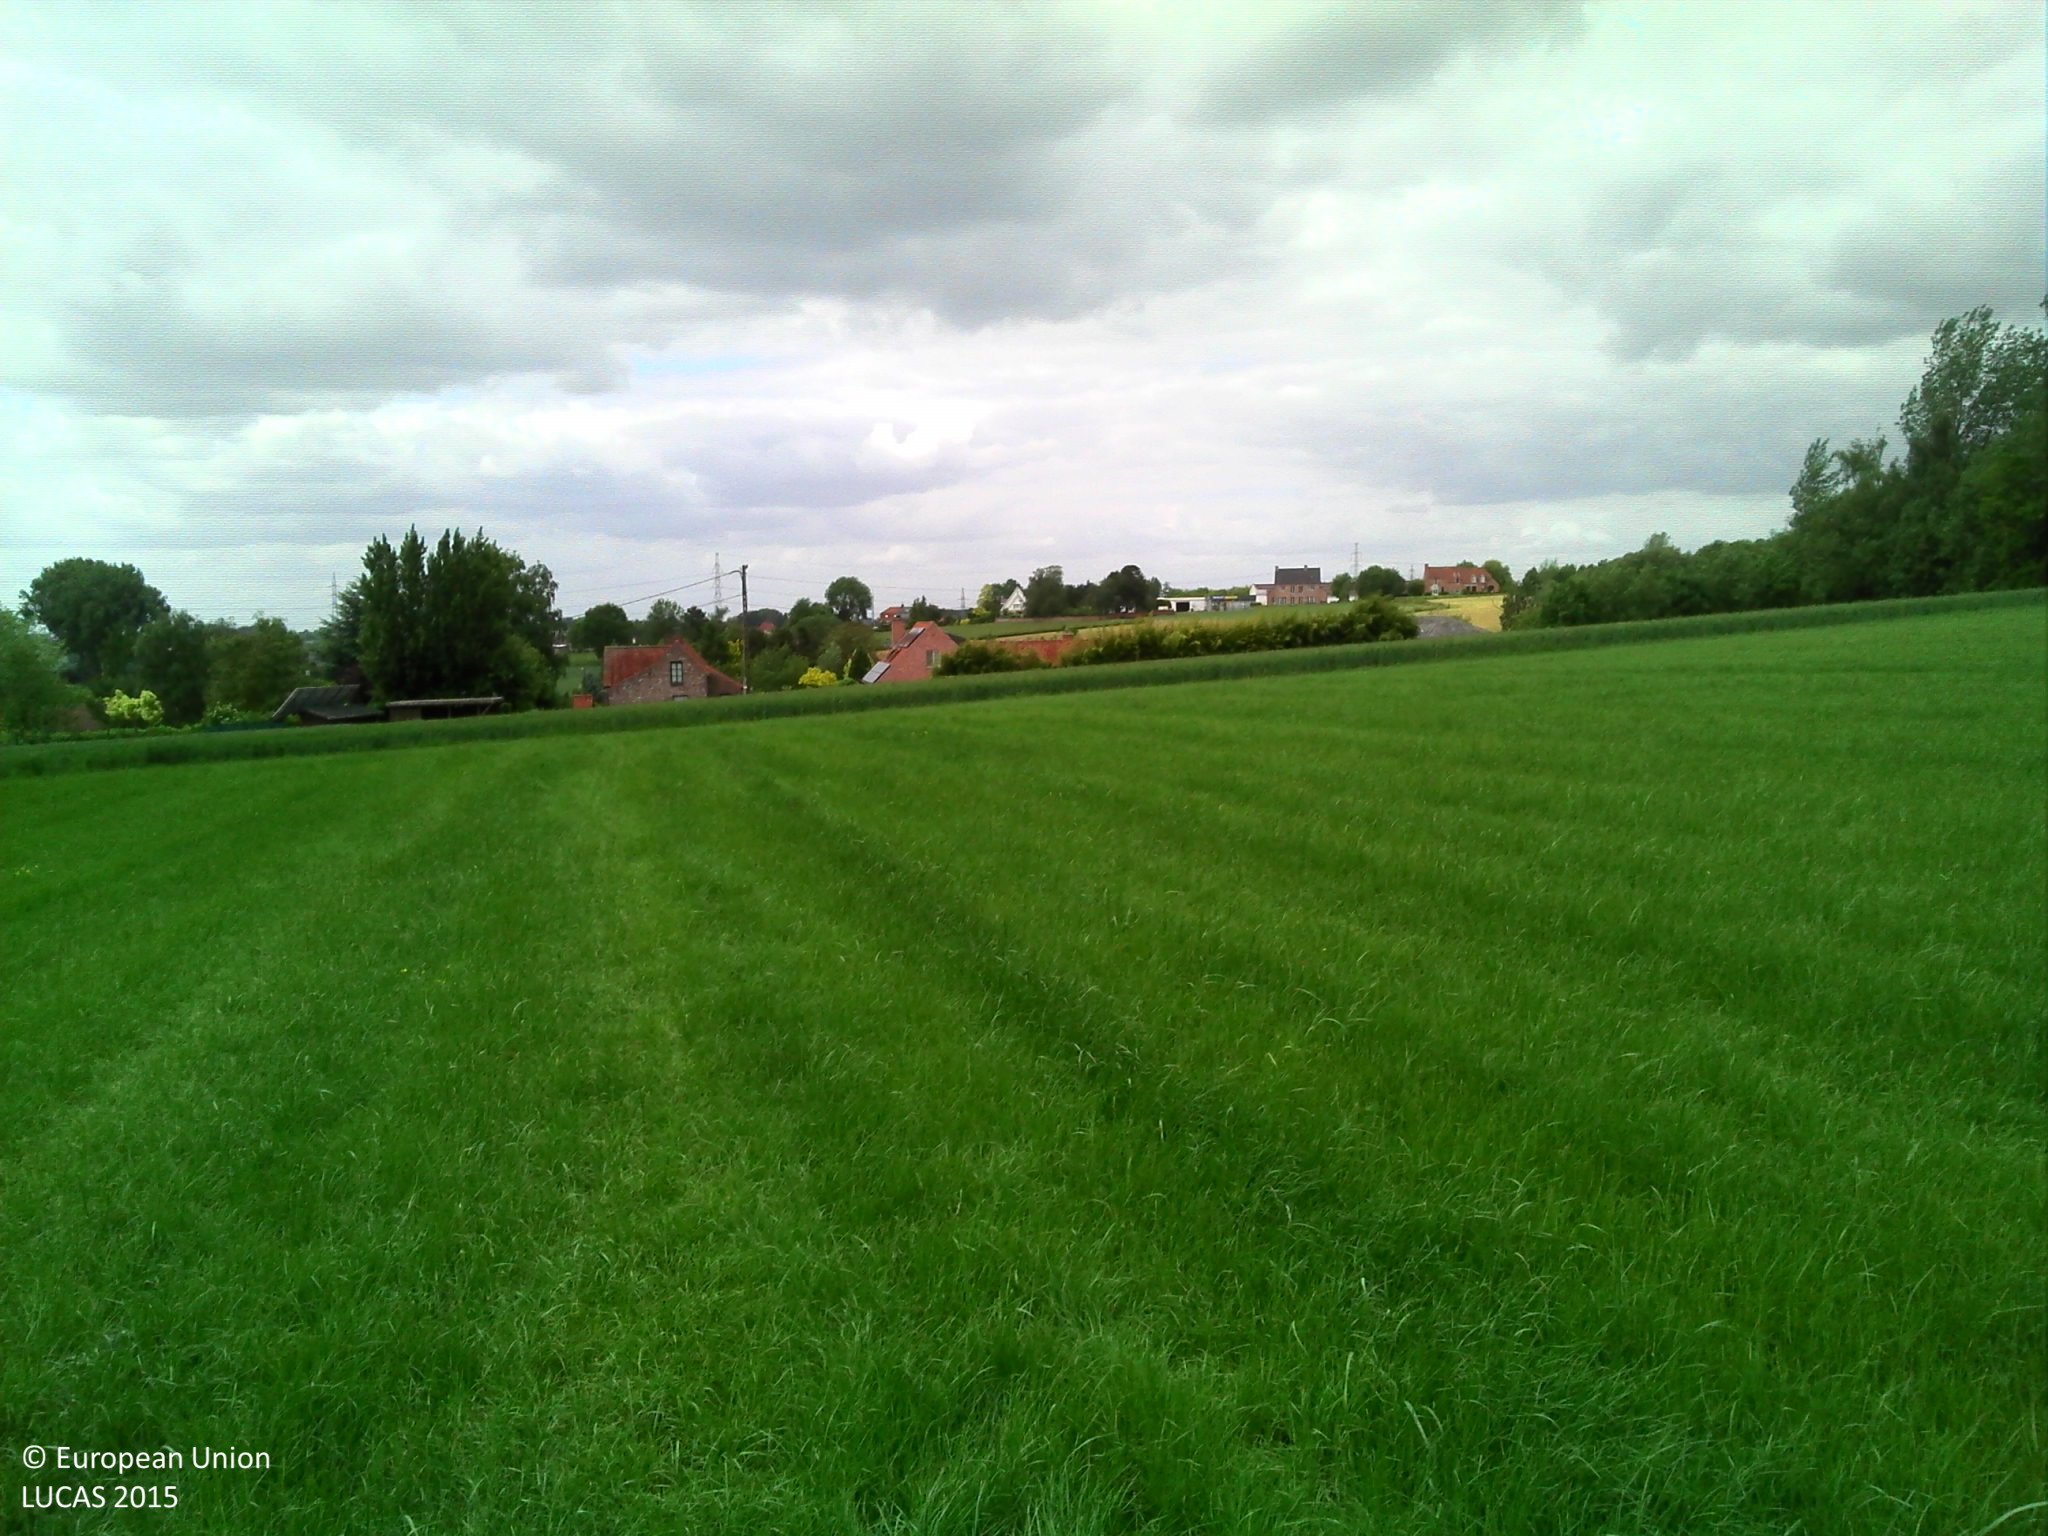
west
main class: Cropland
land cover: Temporary grasslands
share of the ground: > 75 %
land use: Agriculture (excluding fallow land and kitchen gardens)
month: June
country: BE
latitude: 50.8288
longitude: 3.5040
